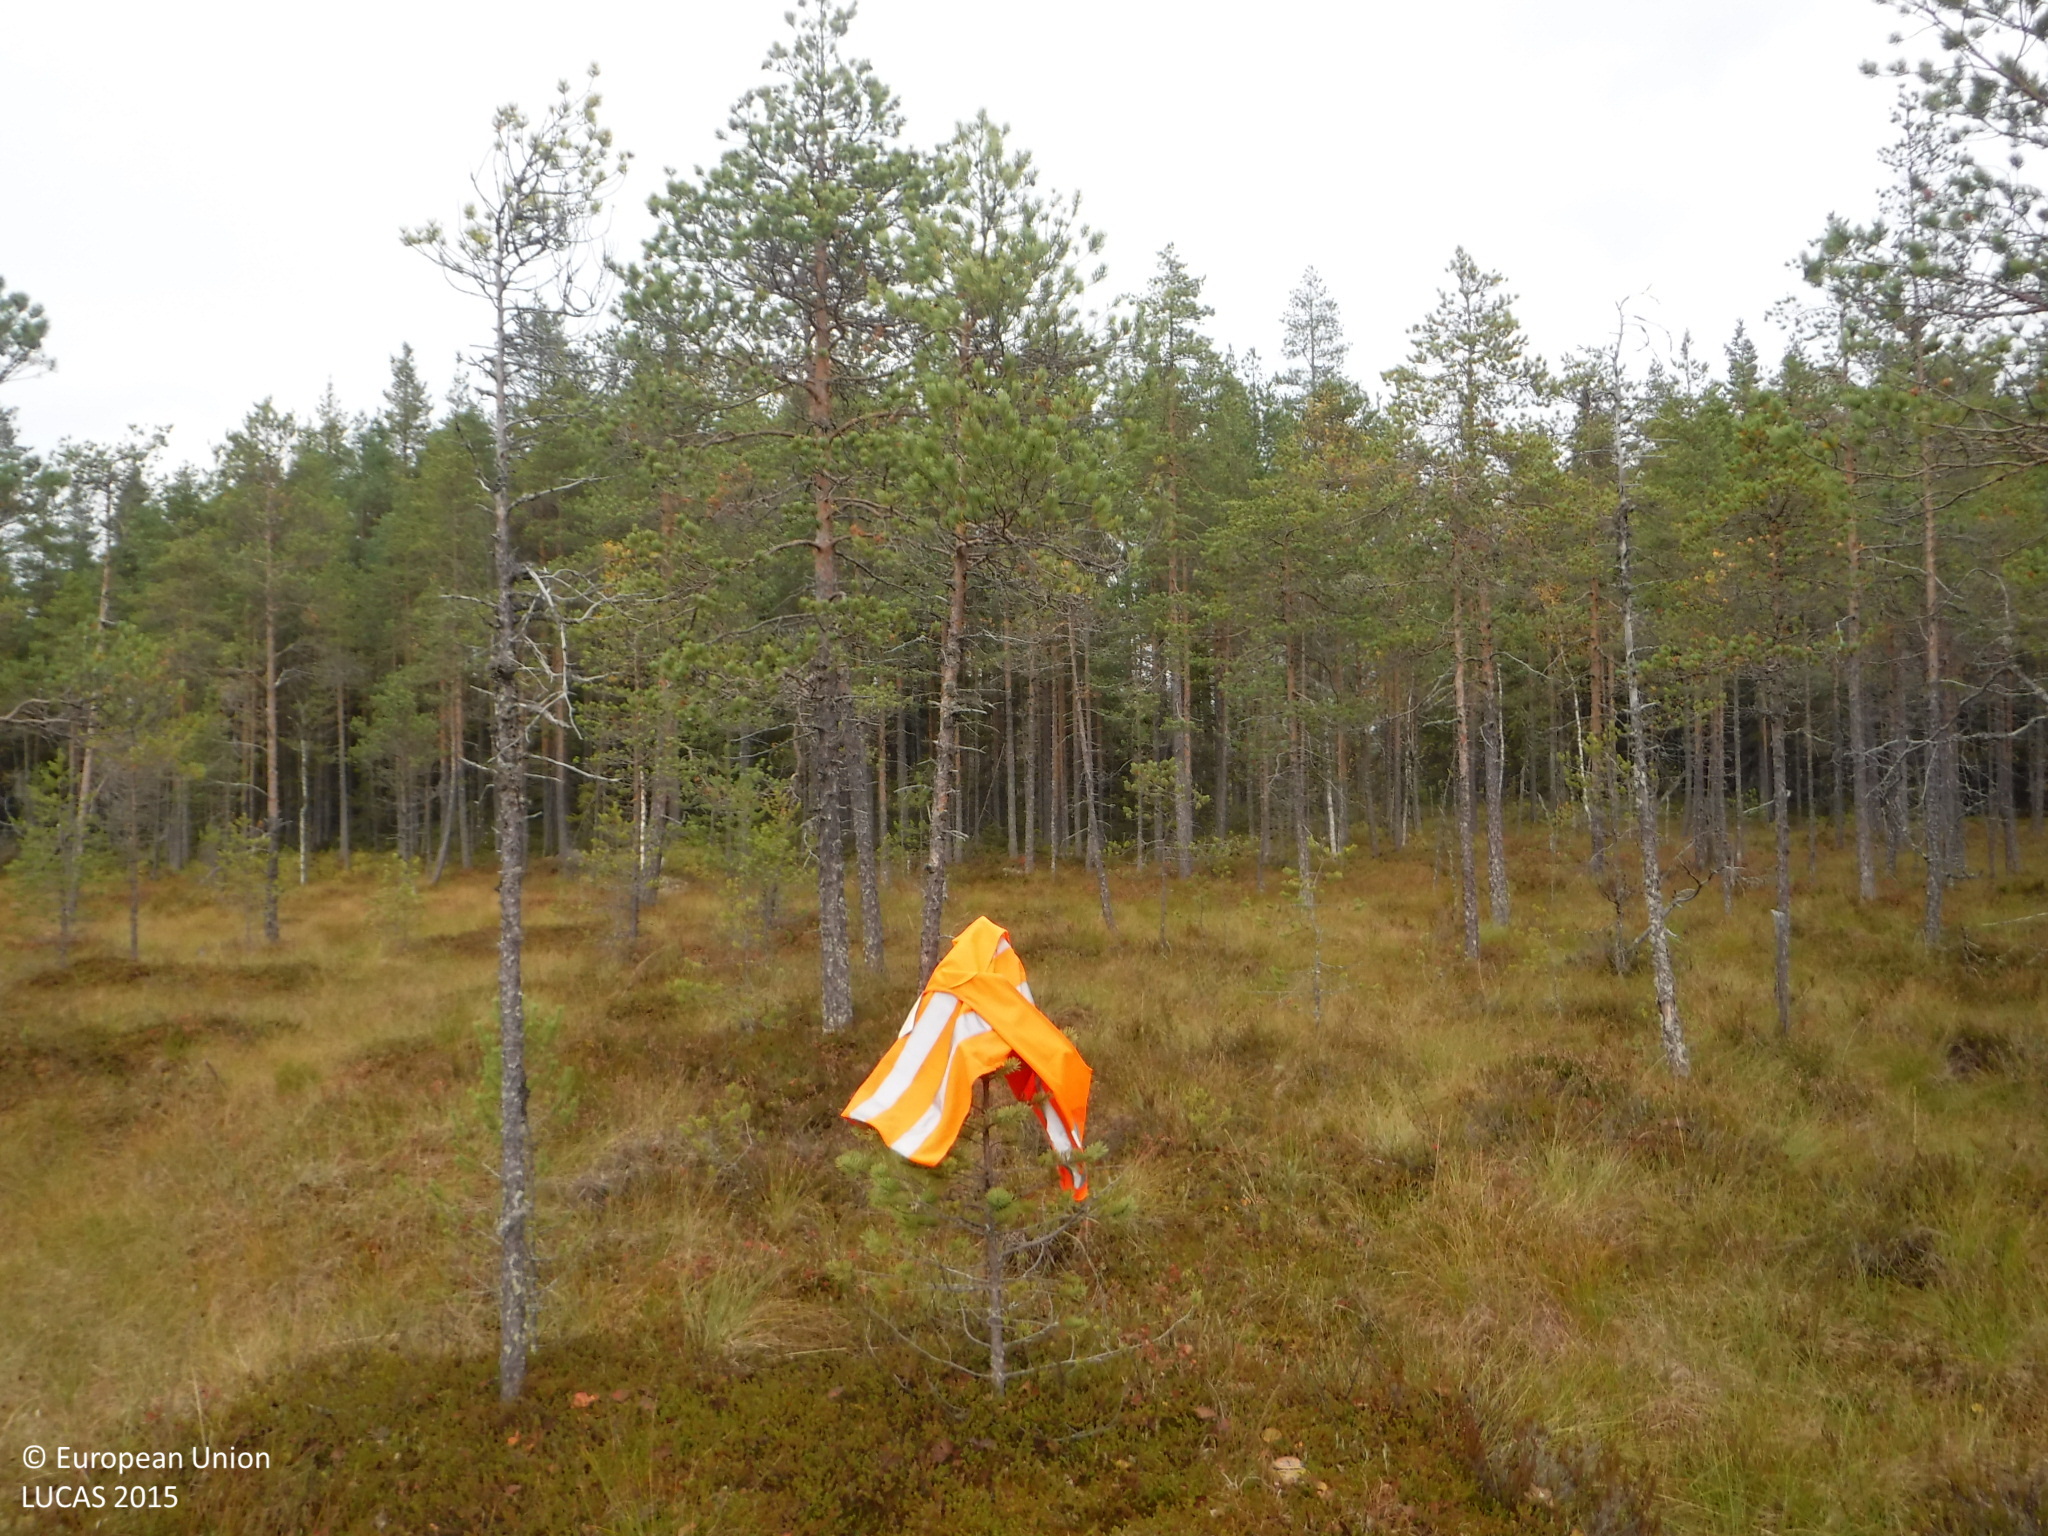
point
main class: Woodland
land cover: Pine dominated coniferous woodland
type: boreal forest
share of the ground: 10 - 25 %
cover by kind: lichens and mosses 55 %, shrubs 30 %, coniferous forest trees 15 %
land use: Semi-natural and natural areas not in use
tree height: > 5 m
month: September
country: FI
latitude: 62.0566
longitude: 23.2896
